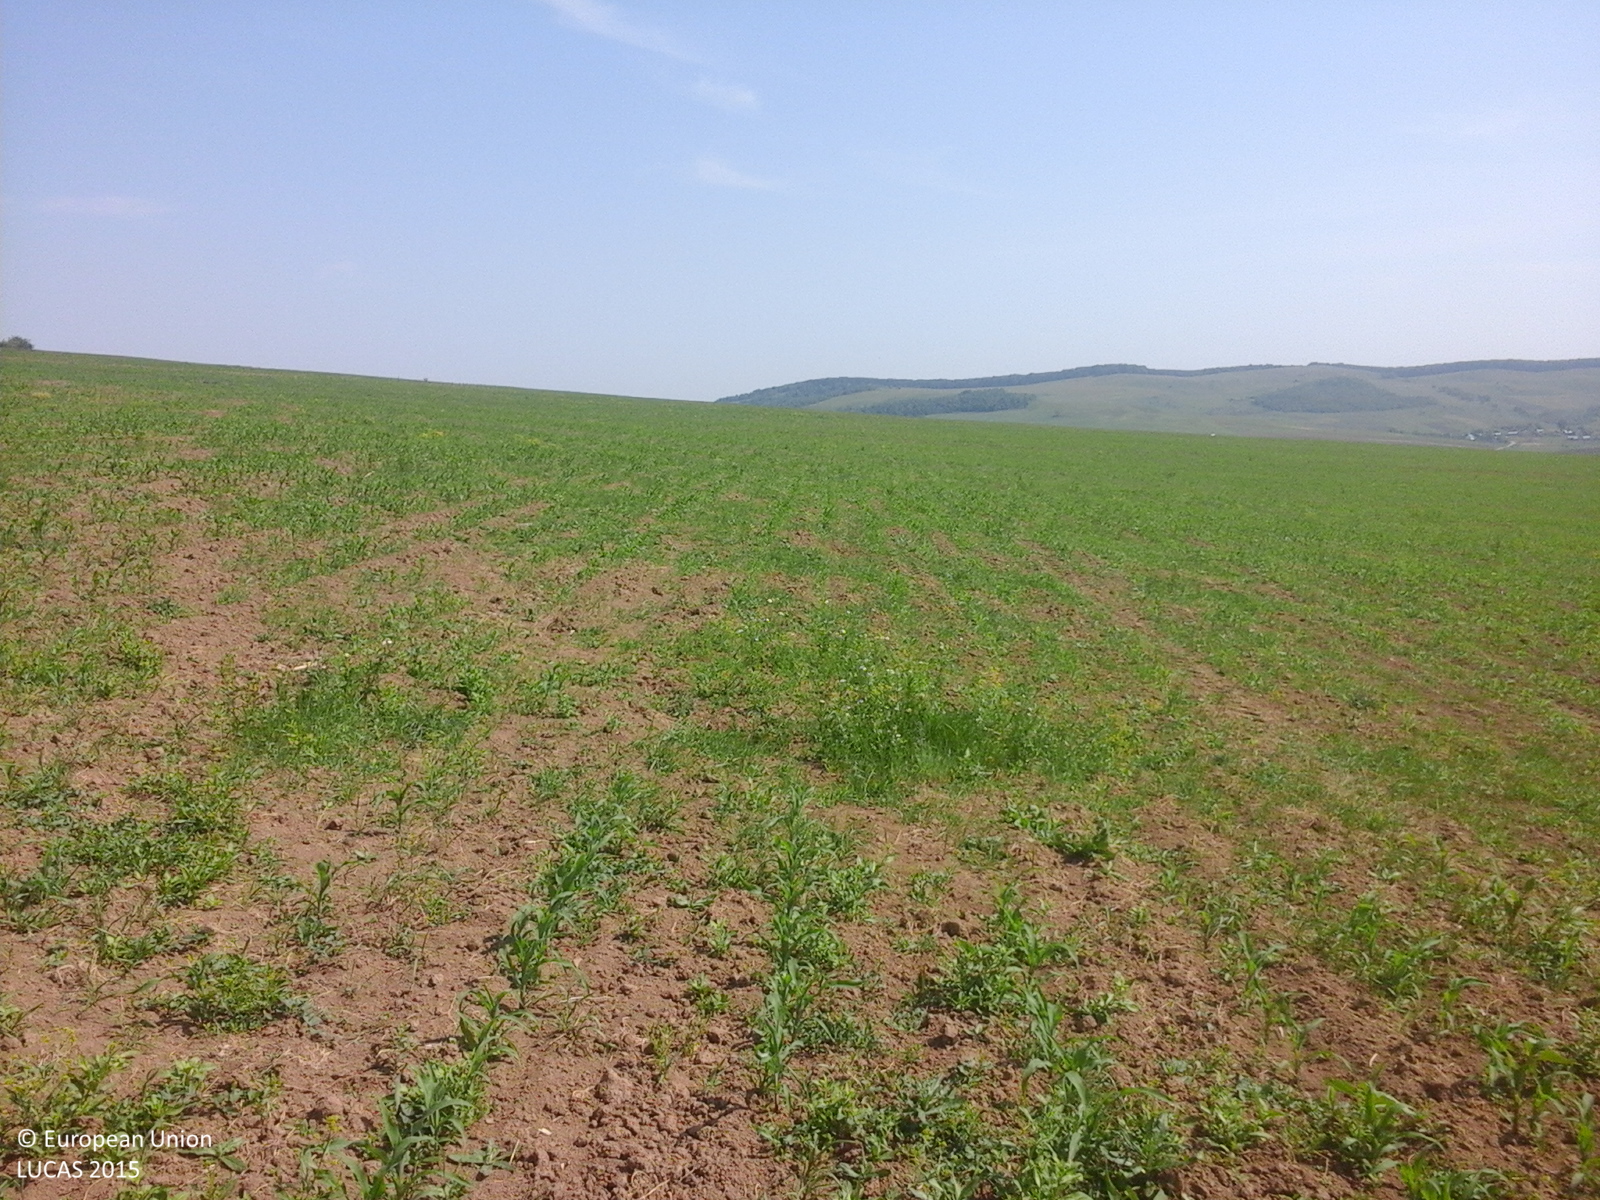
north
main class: Cropland
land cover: Maize
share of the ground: 10 - 25 %
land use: Agriculture (excluding fallow land and kitchen gardens)
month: June
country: RO
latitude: 46.5793
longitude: 27.1026
